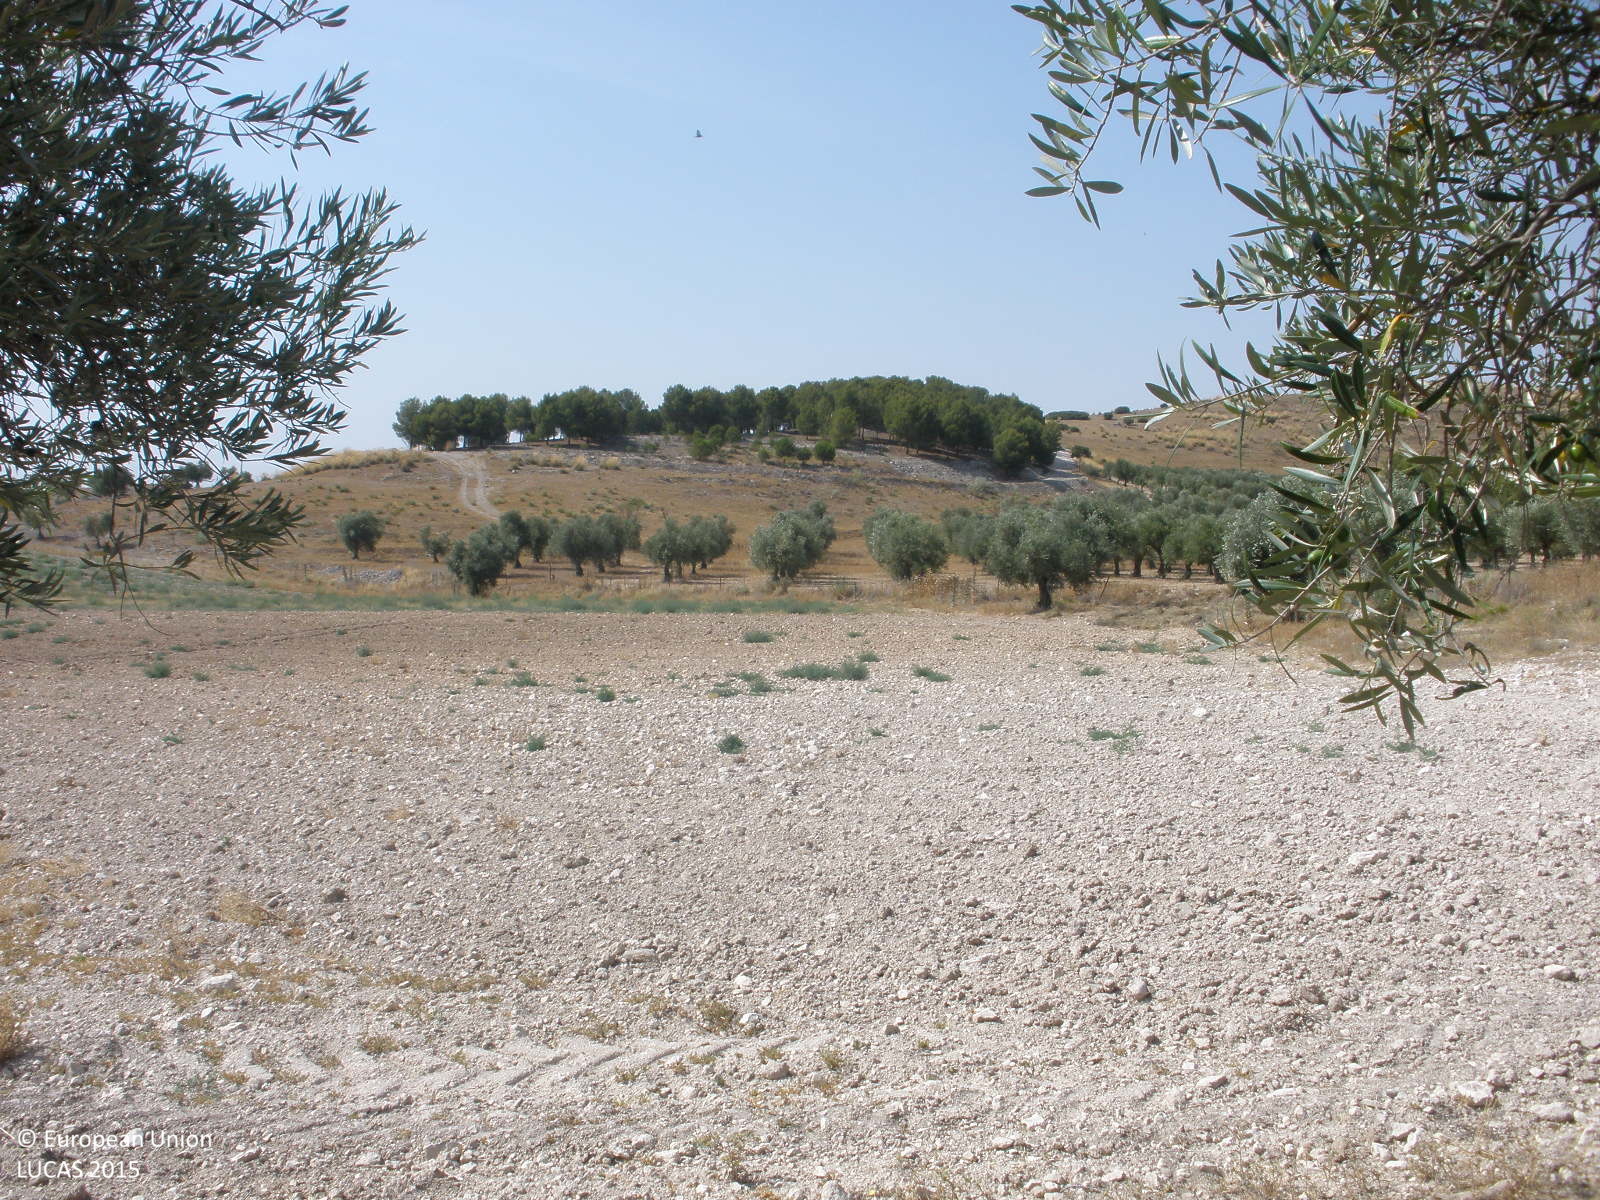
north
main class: Cropland
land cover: Olive groves
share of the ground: 25 - 50 %
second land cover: Grassland without tree/shrub cover
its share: 10 - 25 %
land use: Agriculture (excluding fallow land and kitchen gardens)
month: July
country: ES
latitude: 40.3479
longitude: -3.4191
